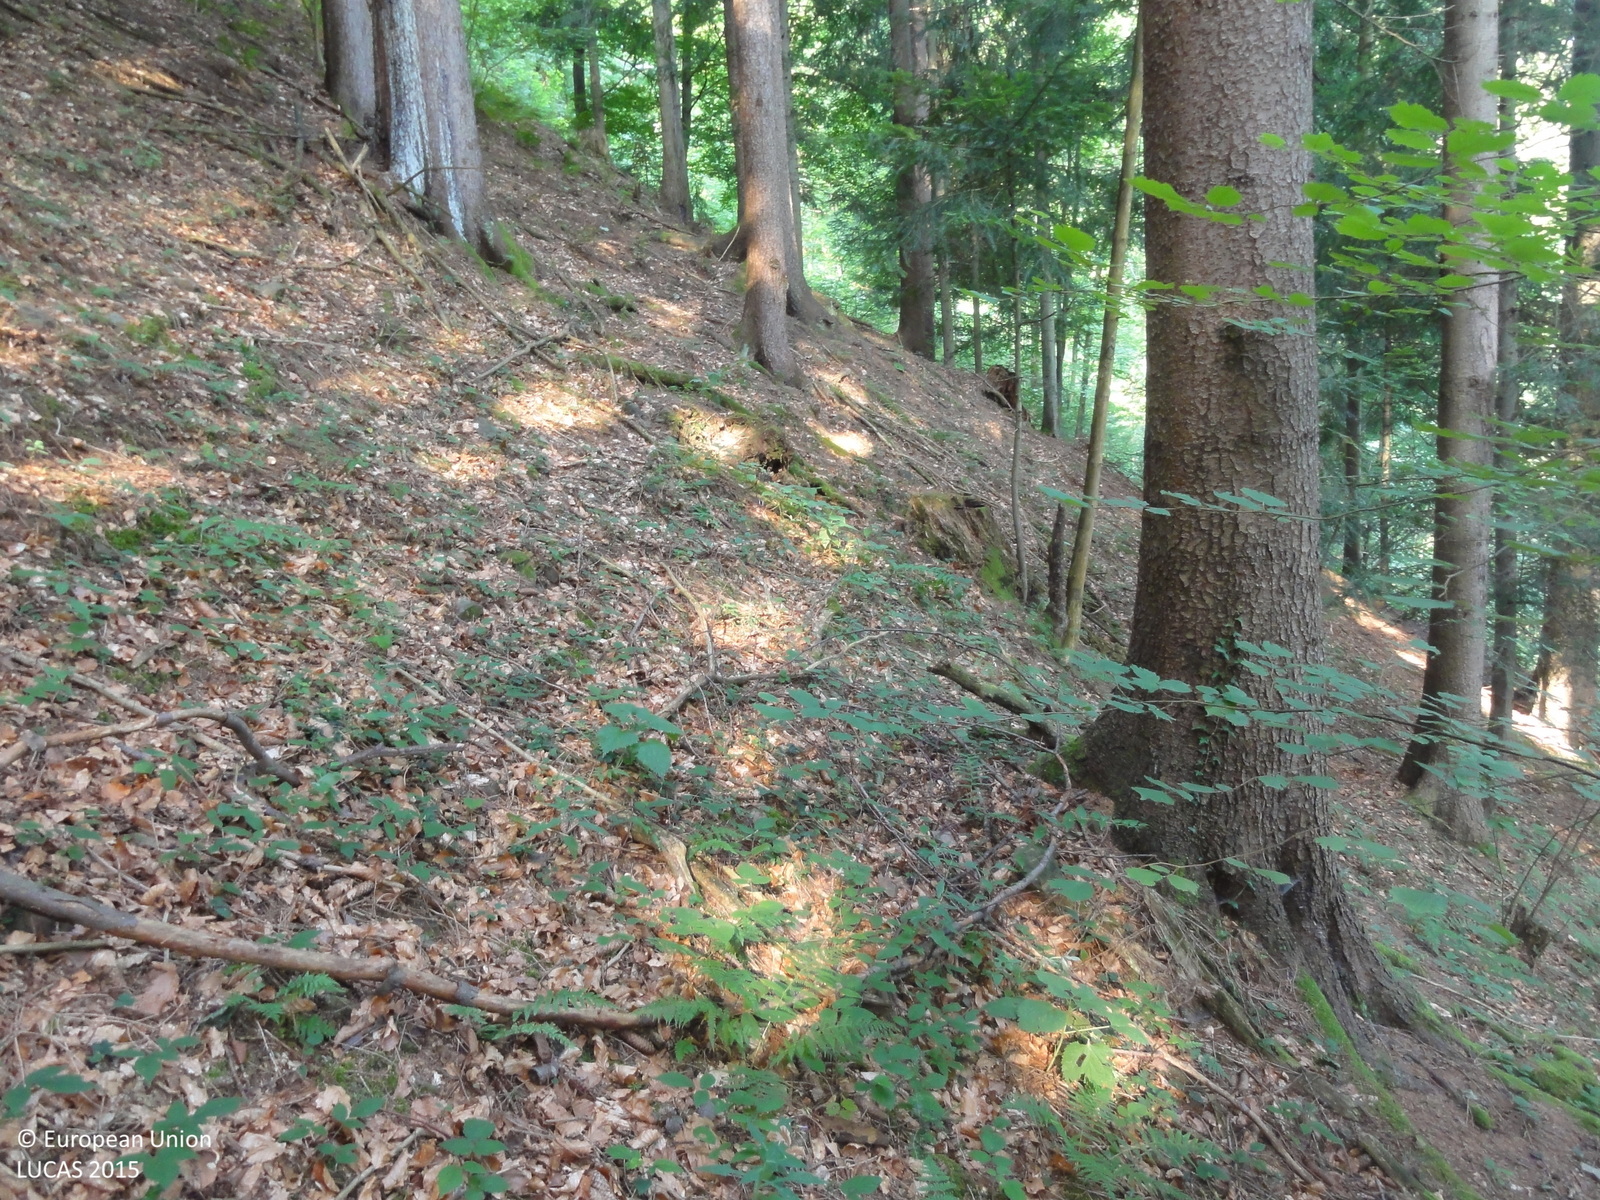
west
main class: Woodland
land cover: Spruce dominated mixed woodland
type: mountainous beech forest
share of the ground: > 75 %
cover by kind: coniferous forest trees 65 %, broadleaved forest trees 35 %
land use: Forestry
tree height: > 5 m
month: July
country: SI
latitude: 46.5532
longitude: 15.1241
